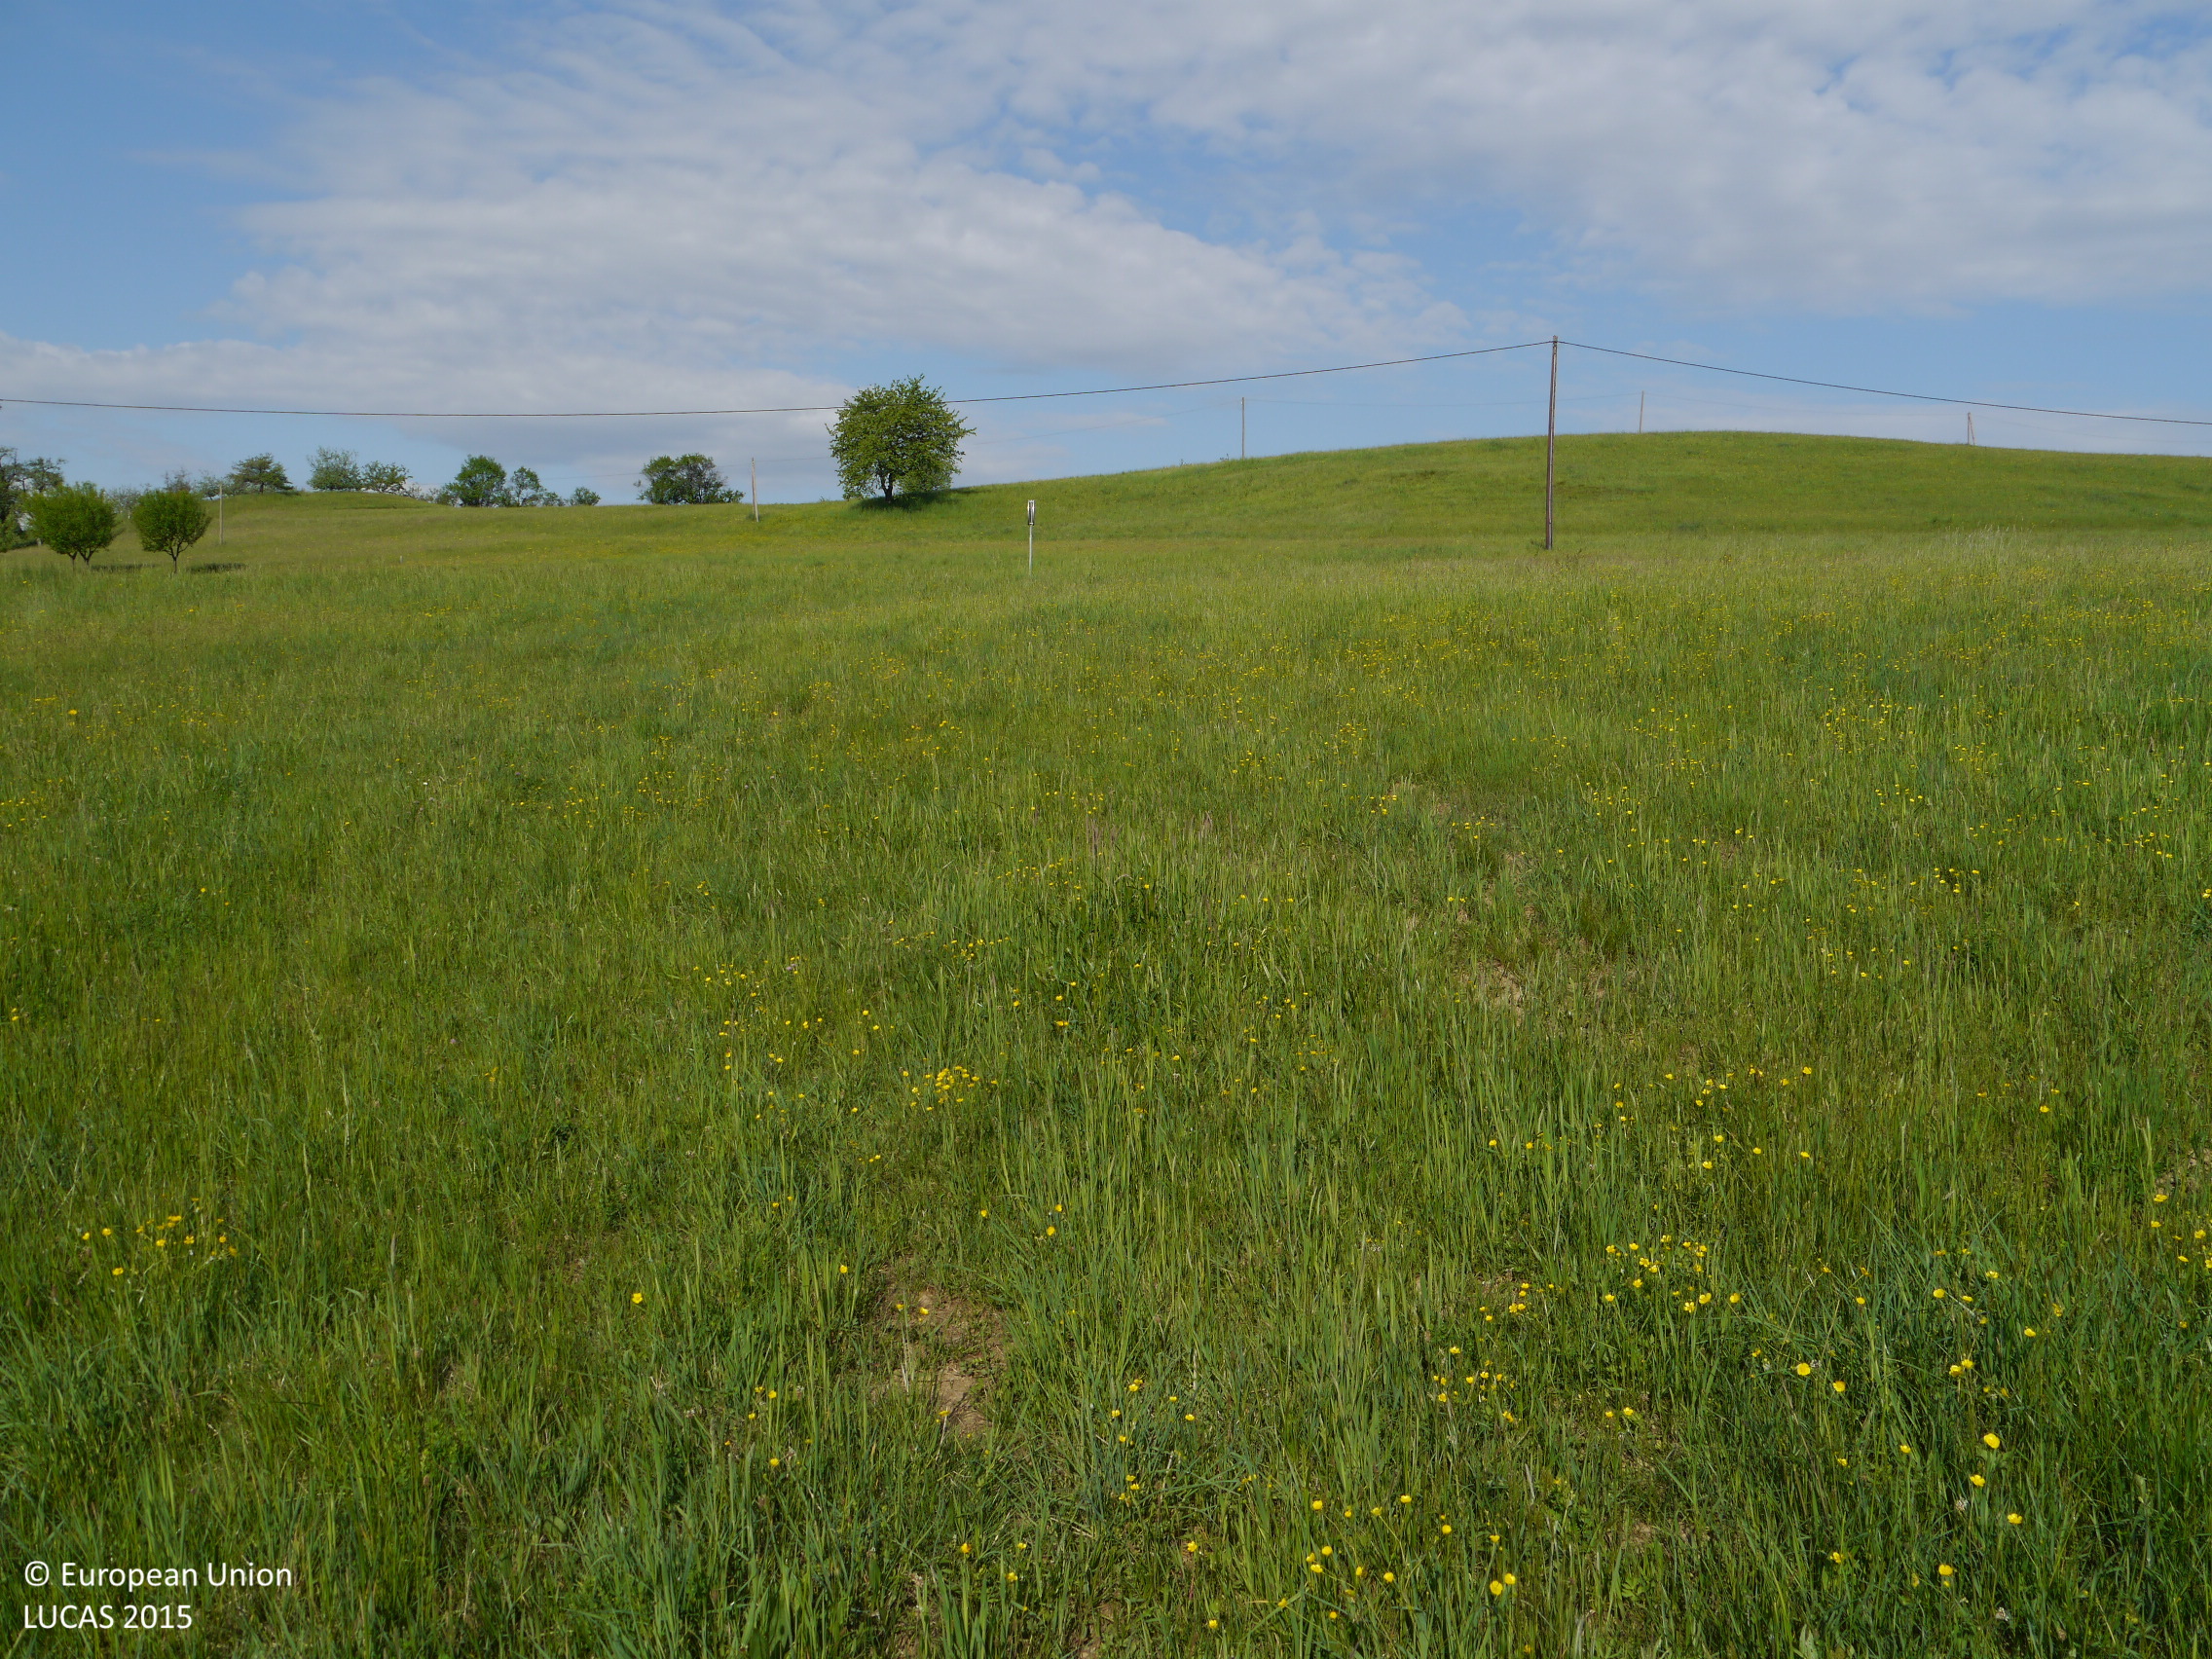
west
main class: Grassland
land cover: Grassland without tree/shrub cover
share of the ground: > 75 %
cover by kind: herbaceous plants 100 %
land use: Agriculture (excluding fallow land and kitchen gardens)
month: May
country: AT
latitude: 47.0331
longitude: 15.2763
